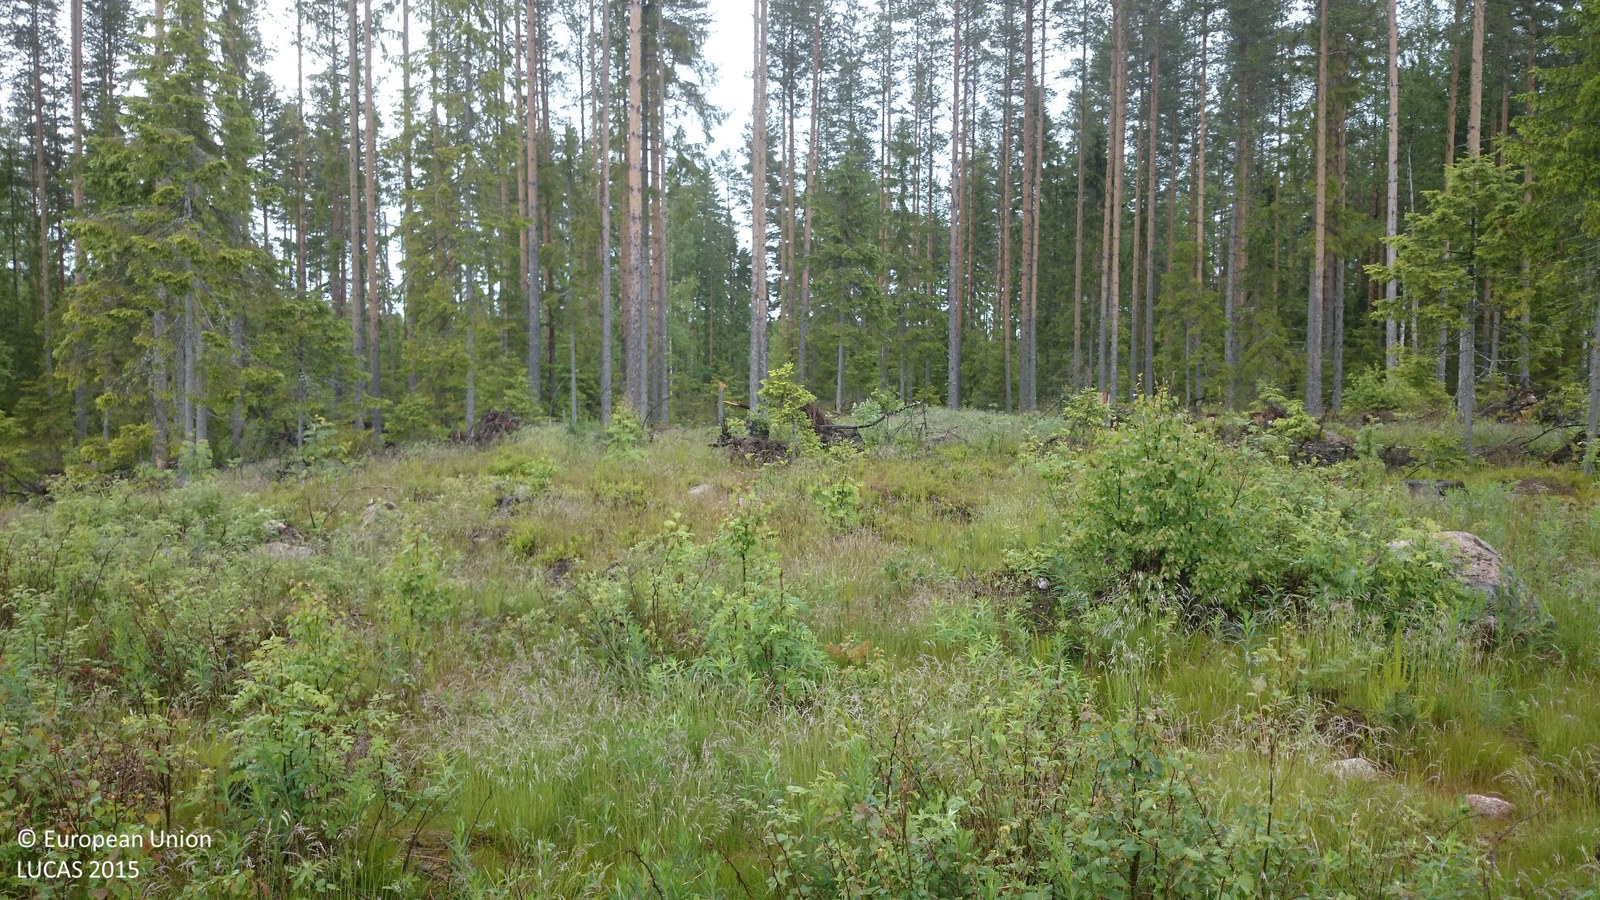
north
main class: Shrubland
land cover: Shrubland with sparse tree cover
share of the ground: 25 - 50 %
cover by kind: herbaceous plants 40 %, shrubs 30 %, lichens and mosses 25 %, coniferous forest trees 5 %
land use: Forestry
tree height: < 5 m
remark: Clear cut
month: June
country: SE
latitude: 61.9848
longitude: 16.8715
